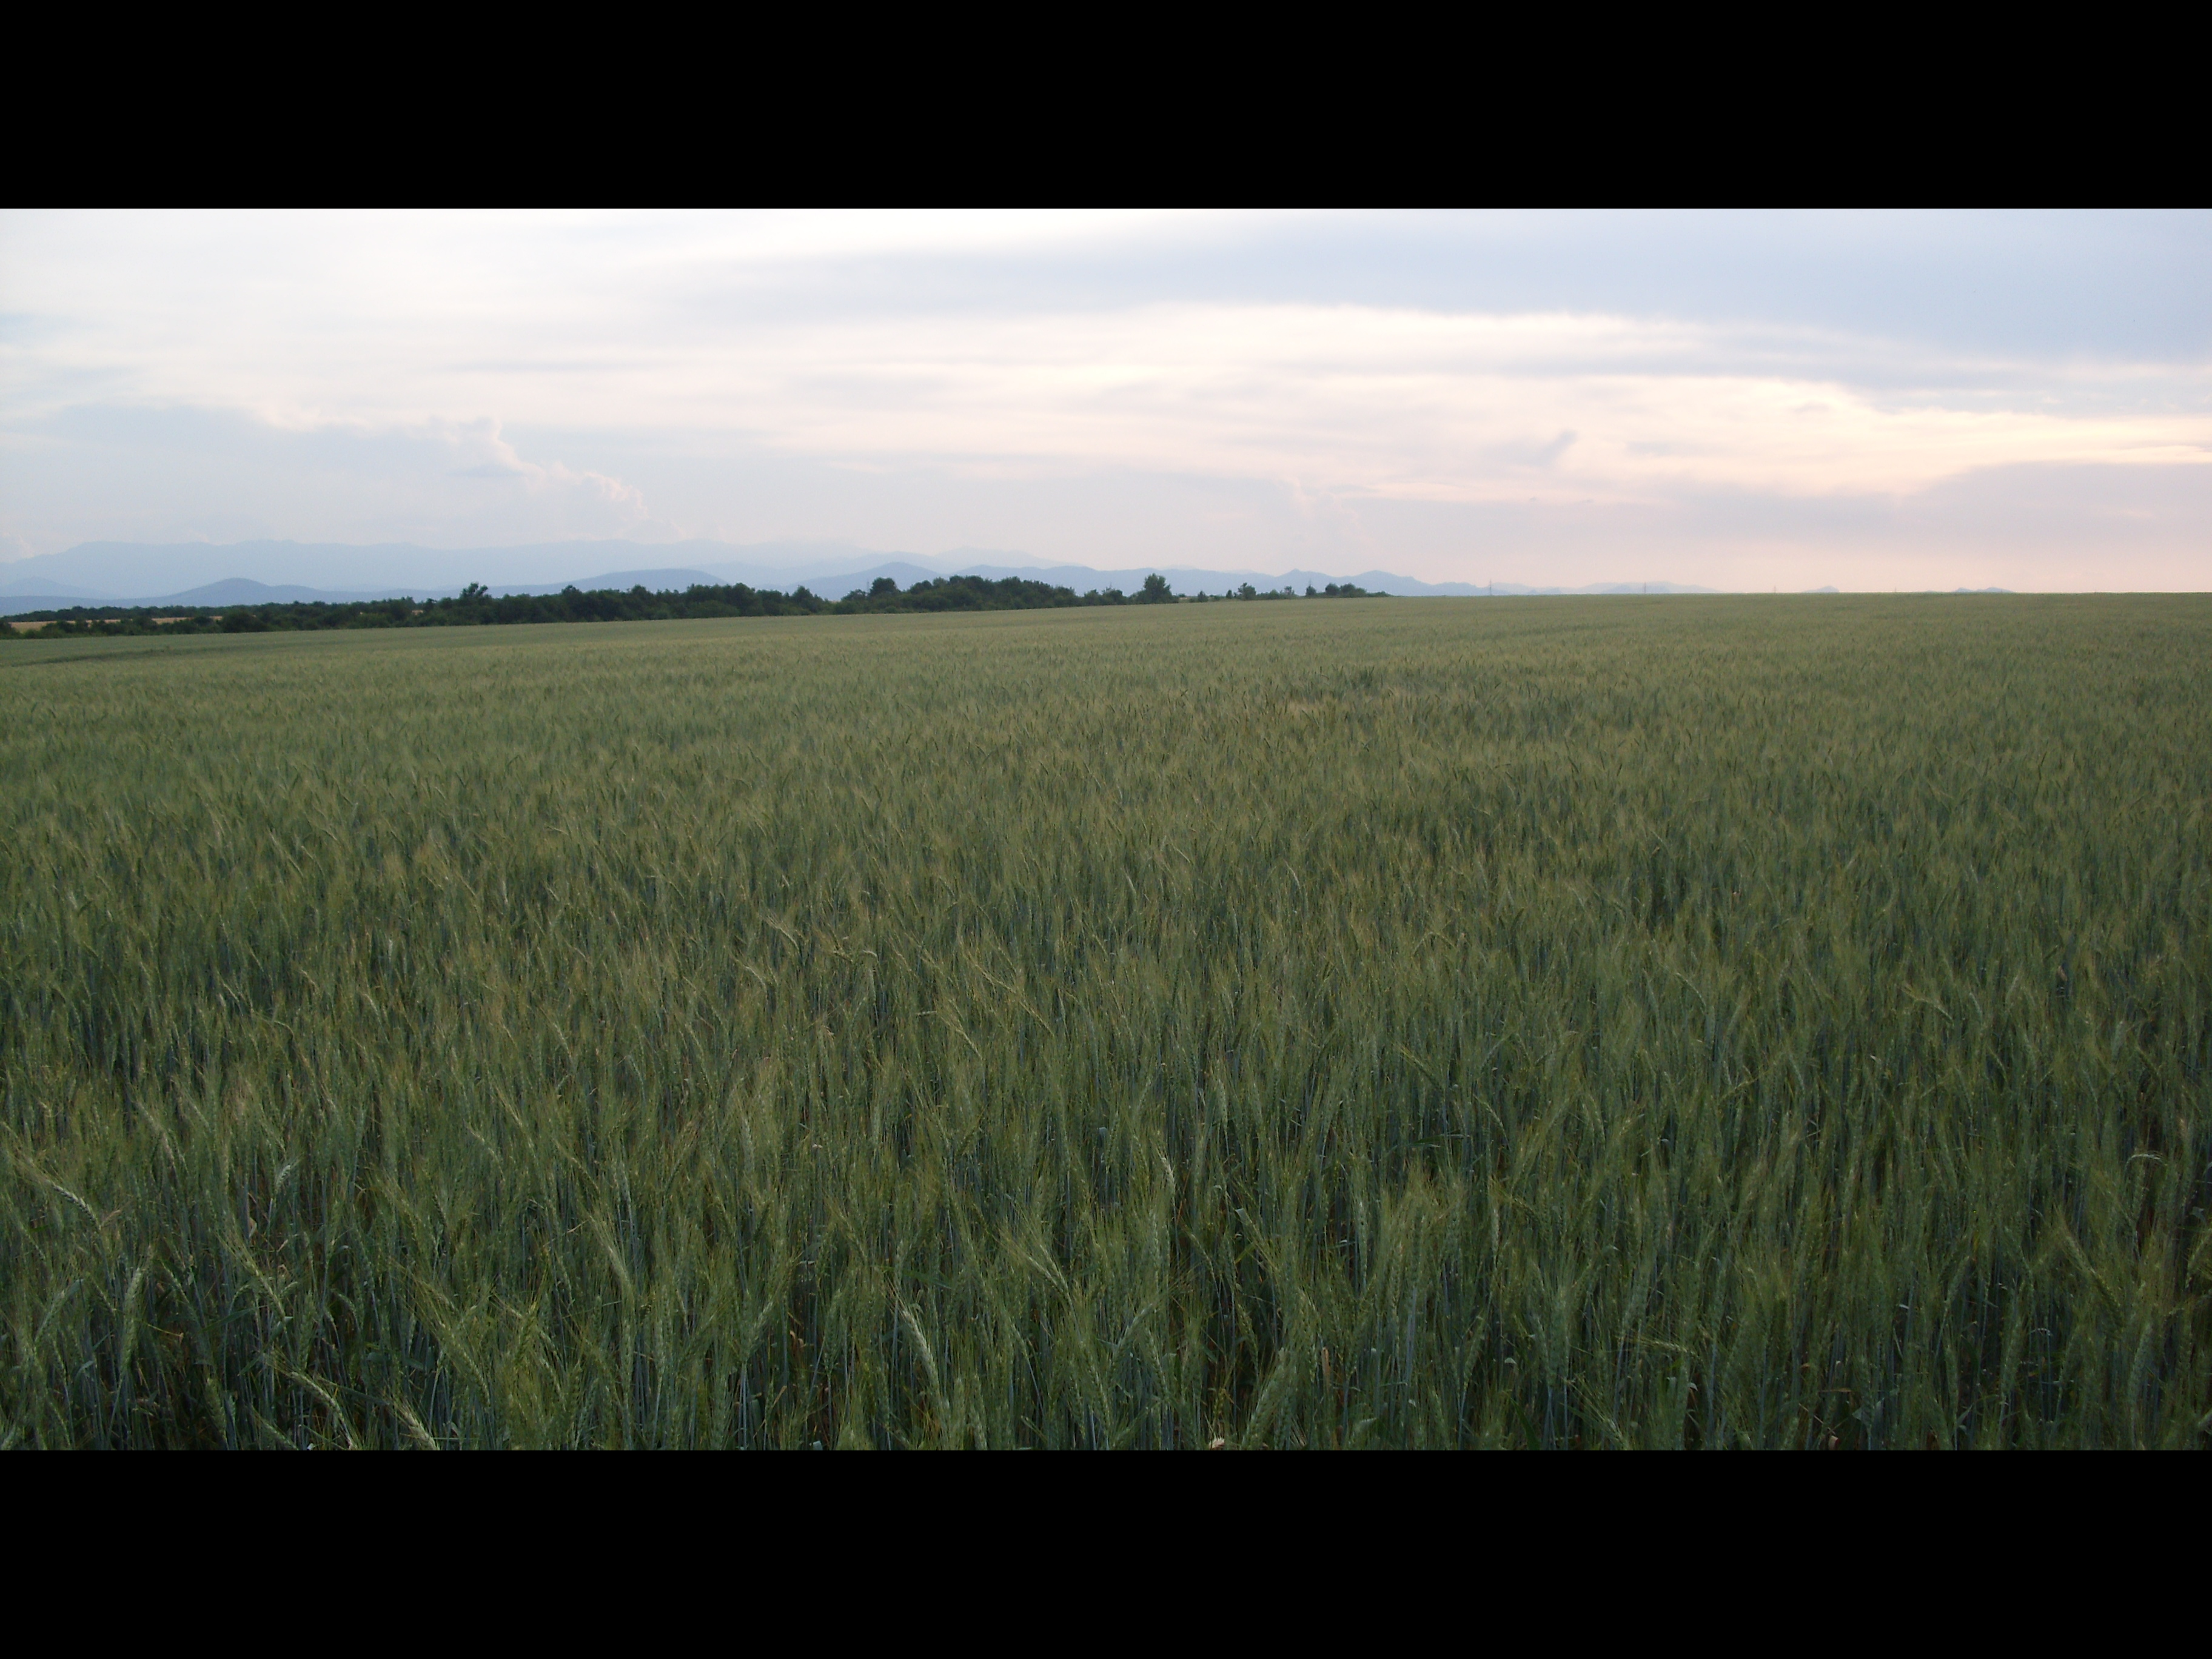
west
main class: Cropland
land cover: Common wheat
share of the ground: > 75 %
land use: Agriculture (excluding fallow land and kitchen gardens)
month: June
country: BG
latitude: 43.5066
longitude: 23.3136
